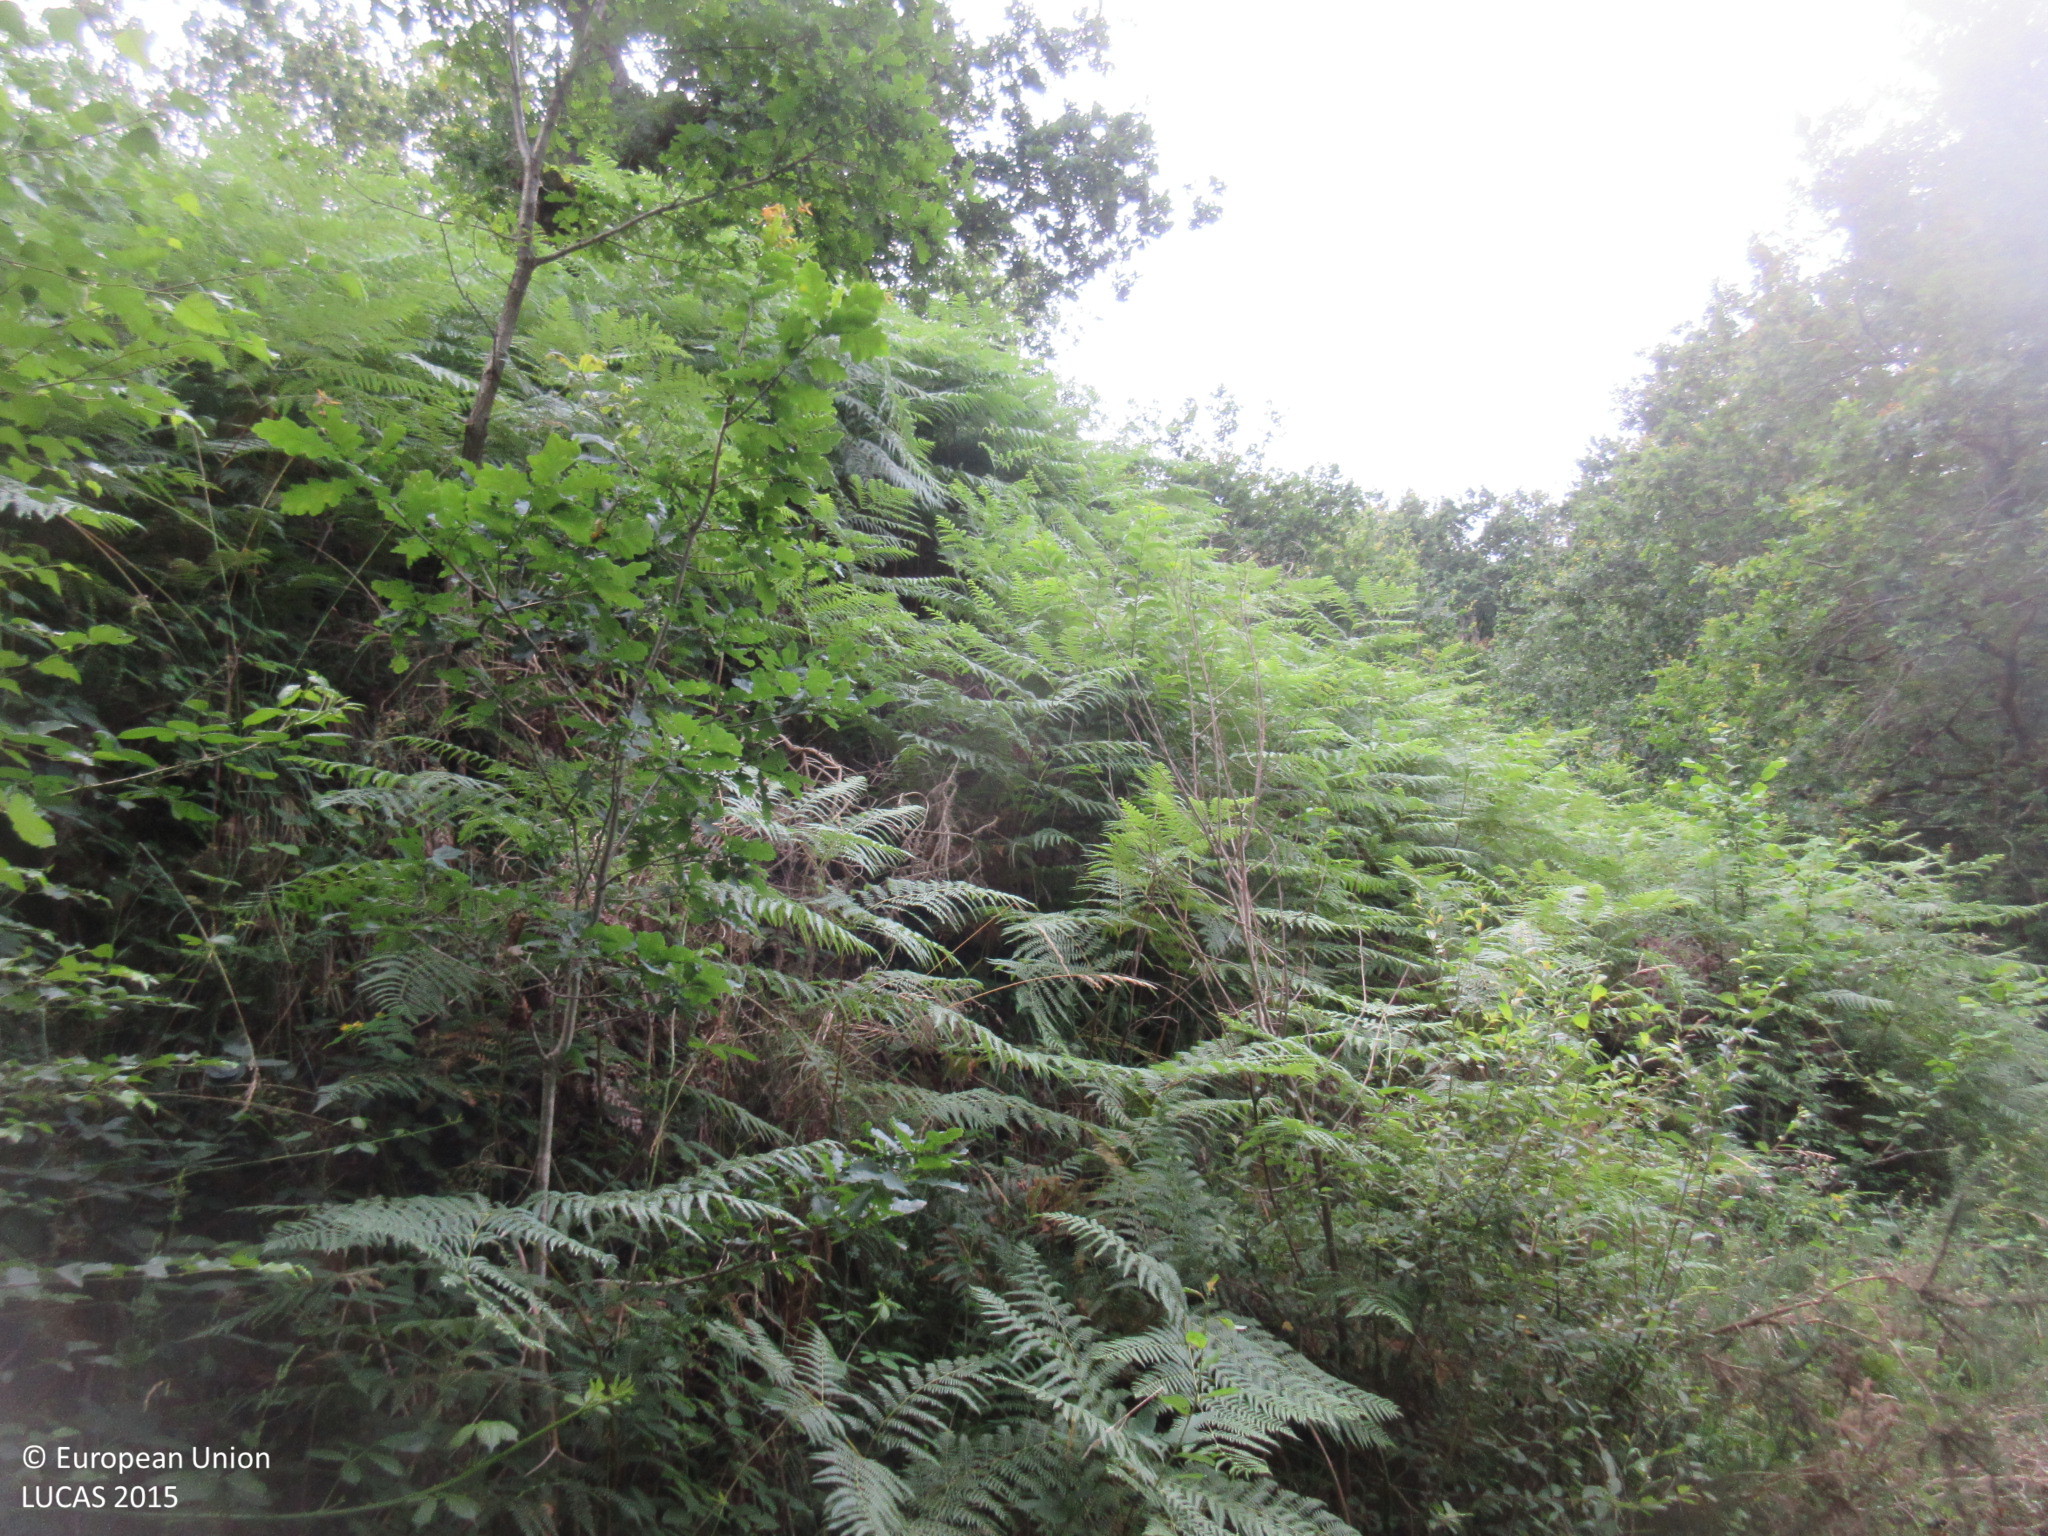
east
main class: Shrubland
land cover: Shrubland without tree cover
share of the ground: > 75 %
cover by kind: shrubs 100 %
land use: Semi-natural and natural areas not in use
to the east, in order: Shrubland without tree cover; Broadleaved woodland; Grassland without tree/shrub cover; Broadleaved woodland; Grassland without tree/shrub cover
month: July
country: ES
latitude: 43.2827
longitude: -3.4872
